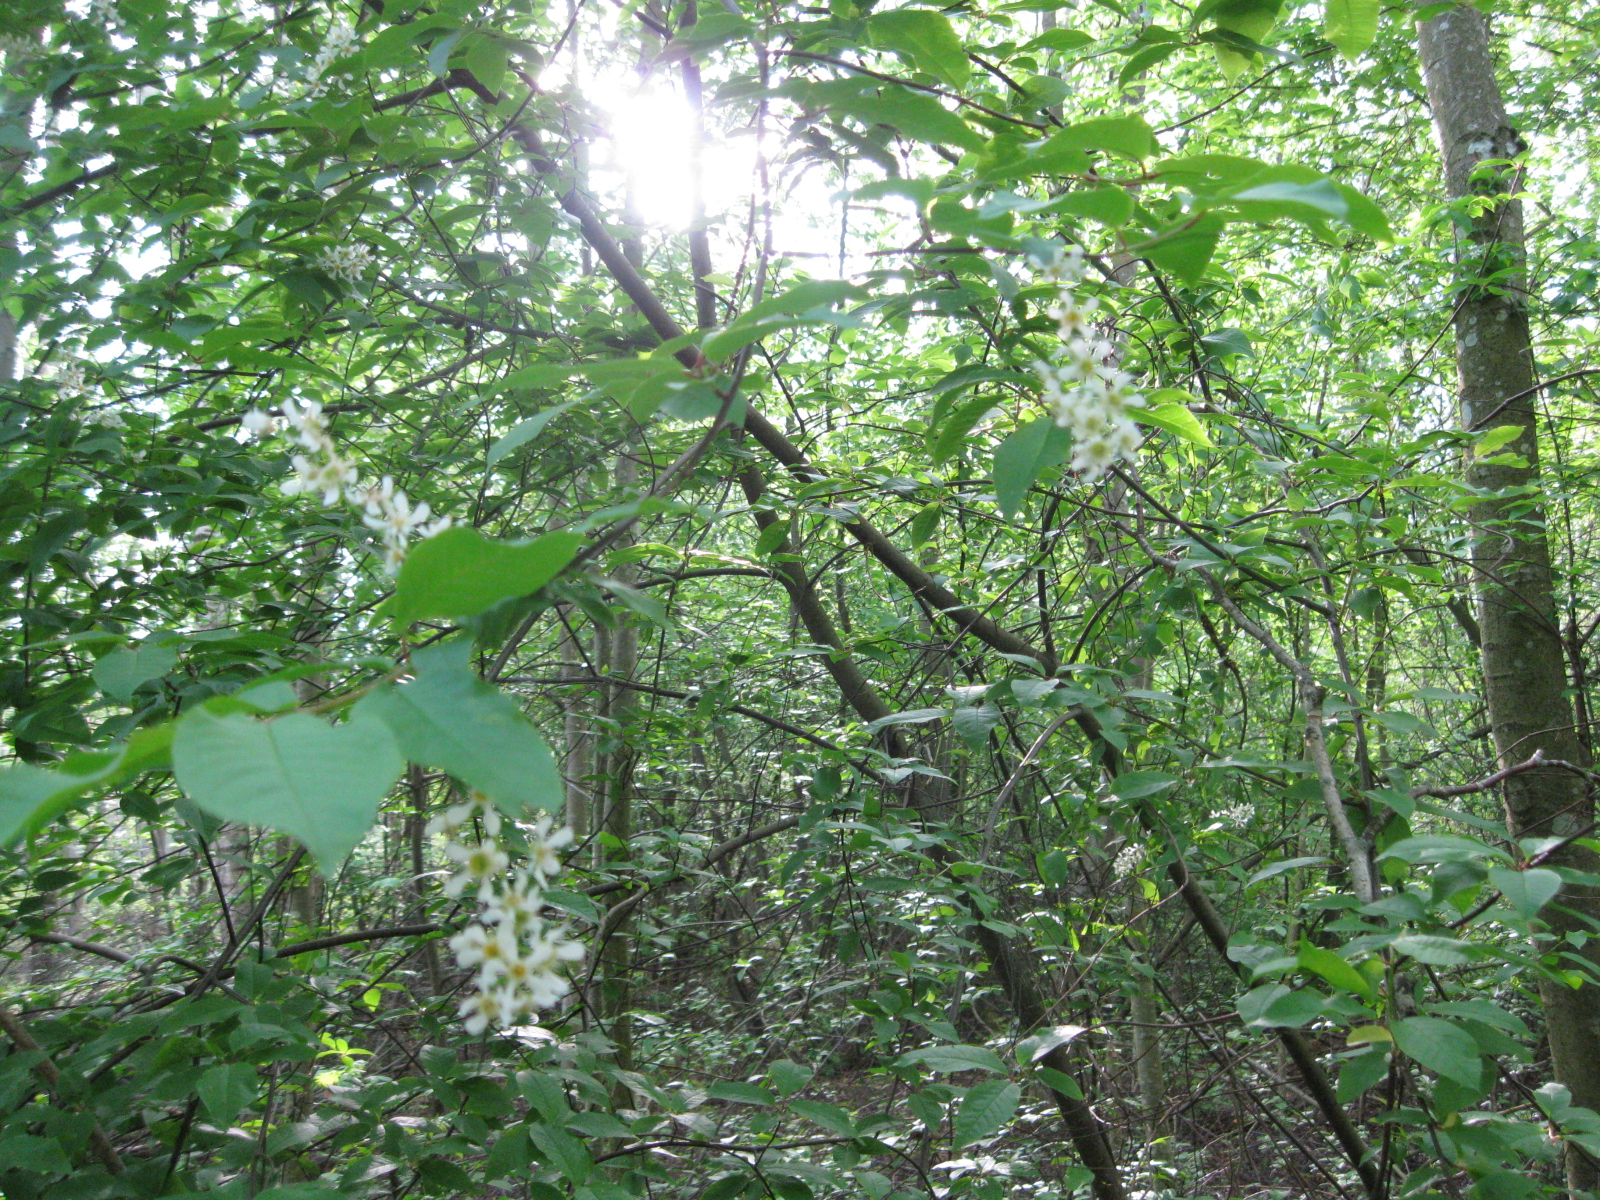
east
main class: Woodland
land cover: Broadleaved woodland
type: non-riverine alder, birch or aspen forest
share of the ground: > 75 %
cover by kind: broadleaved forest trees 90 %, herbaceous plants 10 %
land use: Forestry
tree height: > 5 m
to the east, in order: Broadleaved woodland; Ditches and canals; Broadleaved woodland; Ditches and canals; Broadleaved woodland; Ditches and canals; Broadleaved woodland
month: May
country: LT
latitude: 56.2397
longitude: 24.4727
